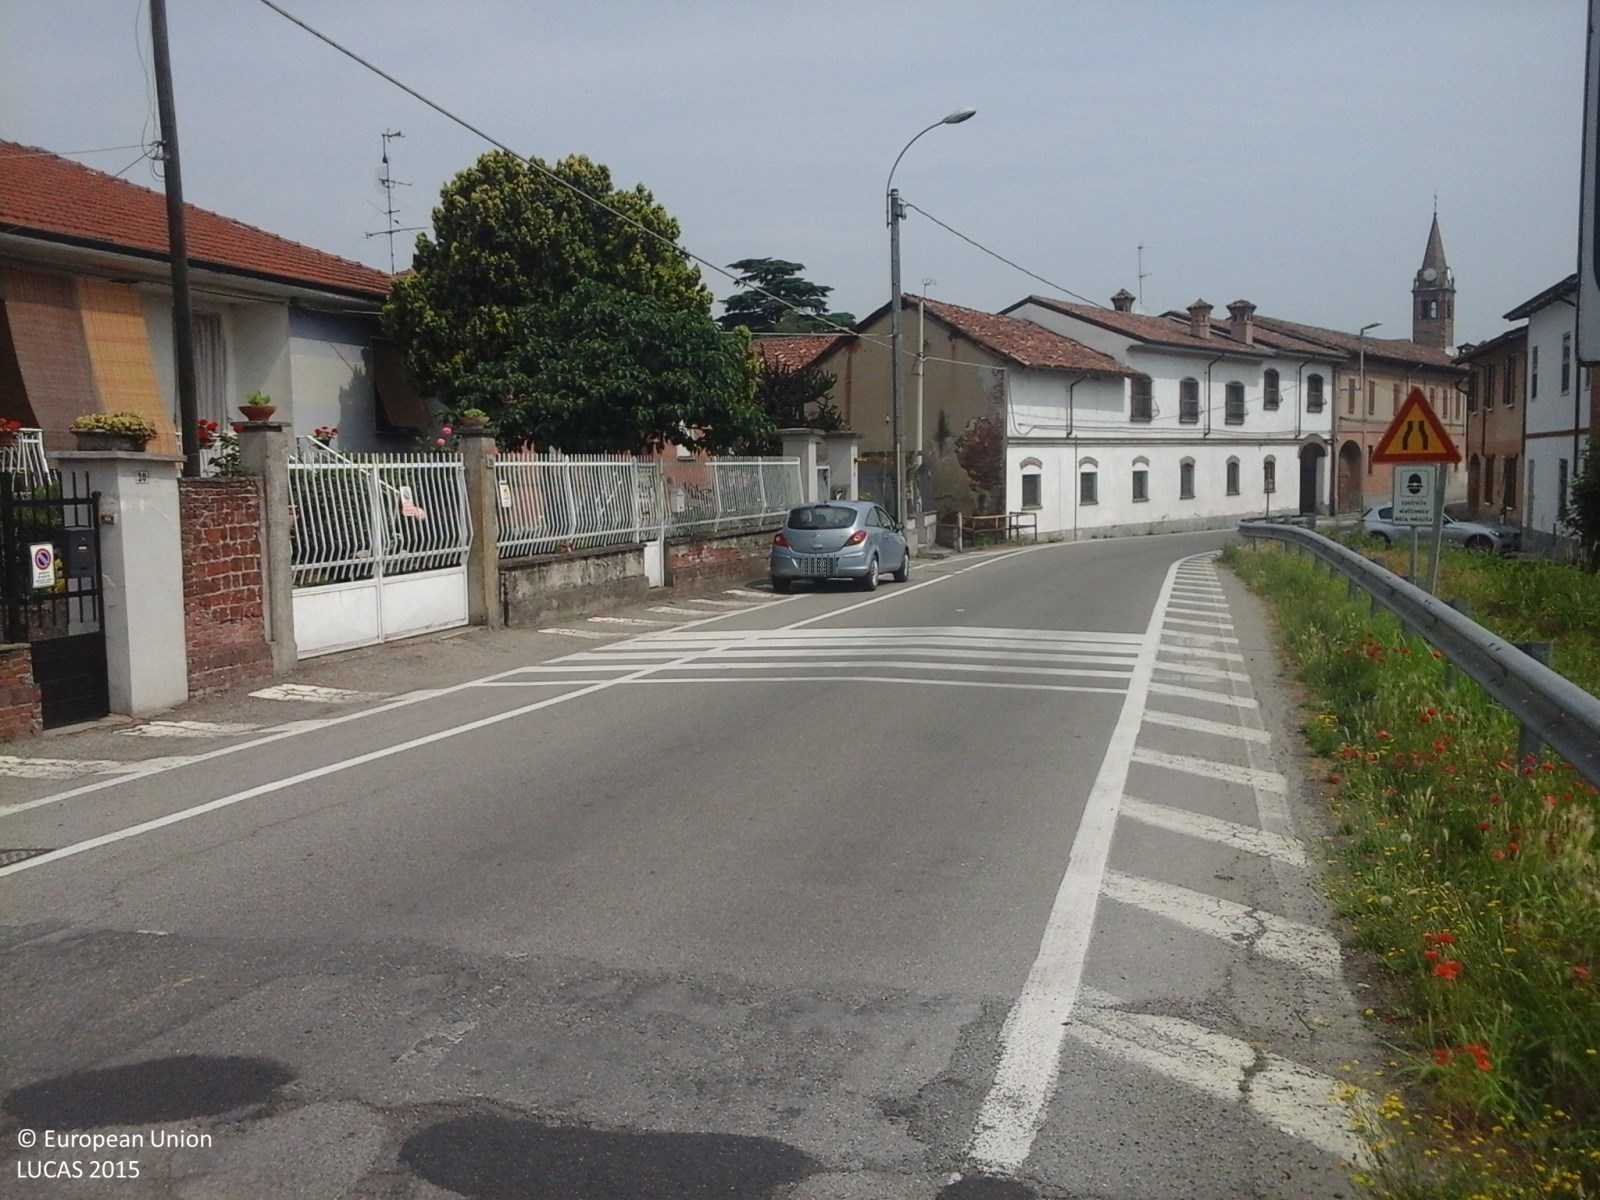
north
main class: Grassland
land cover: Grassland without tree/shrub cover
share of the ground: > 75 %
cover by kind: herbaceous plants 100 %
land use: Agriculture (excluding fallow land and kitchen gardens)
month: June
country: IT
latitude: 45.1190
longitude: 8.7946
